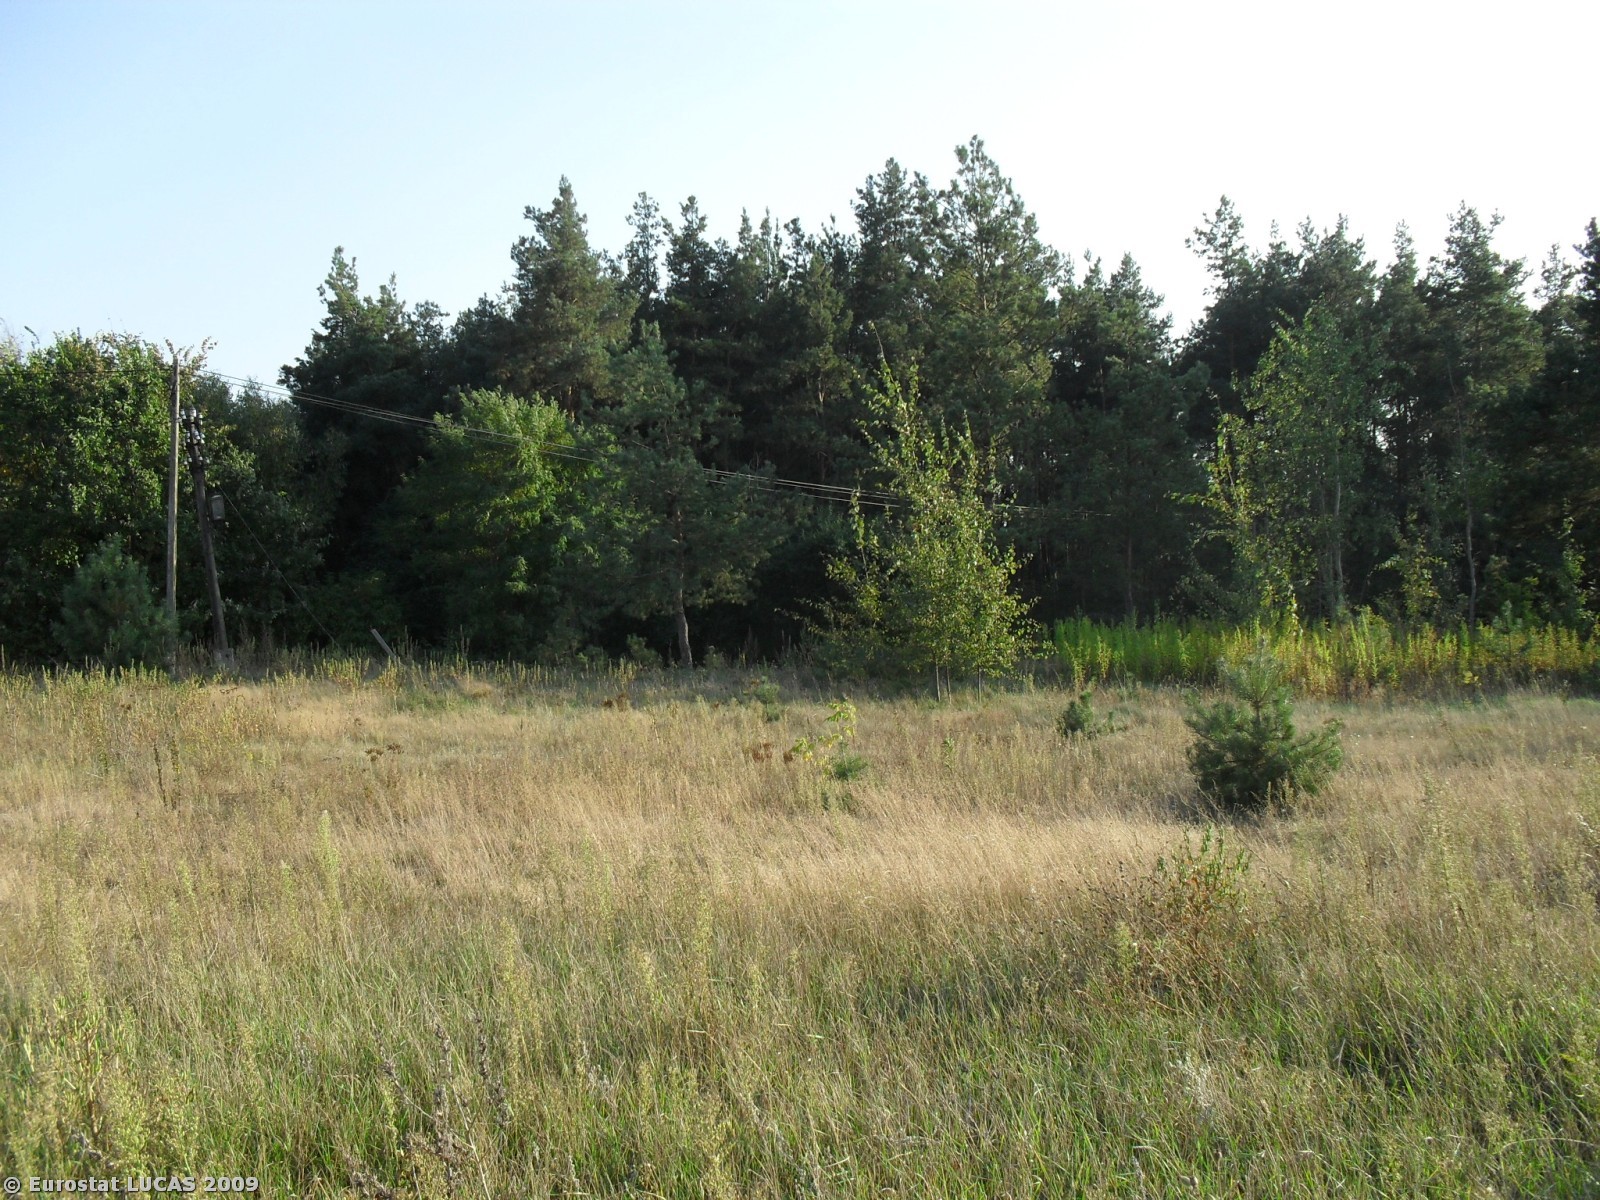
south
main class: Grassland
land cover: Grassland without tree/shrub cover
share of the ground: > 75 %
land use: Unused
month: September
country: PL
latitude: 51.9766
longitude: 20.7709
